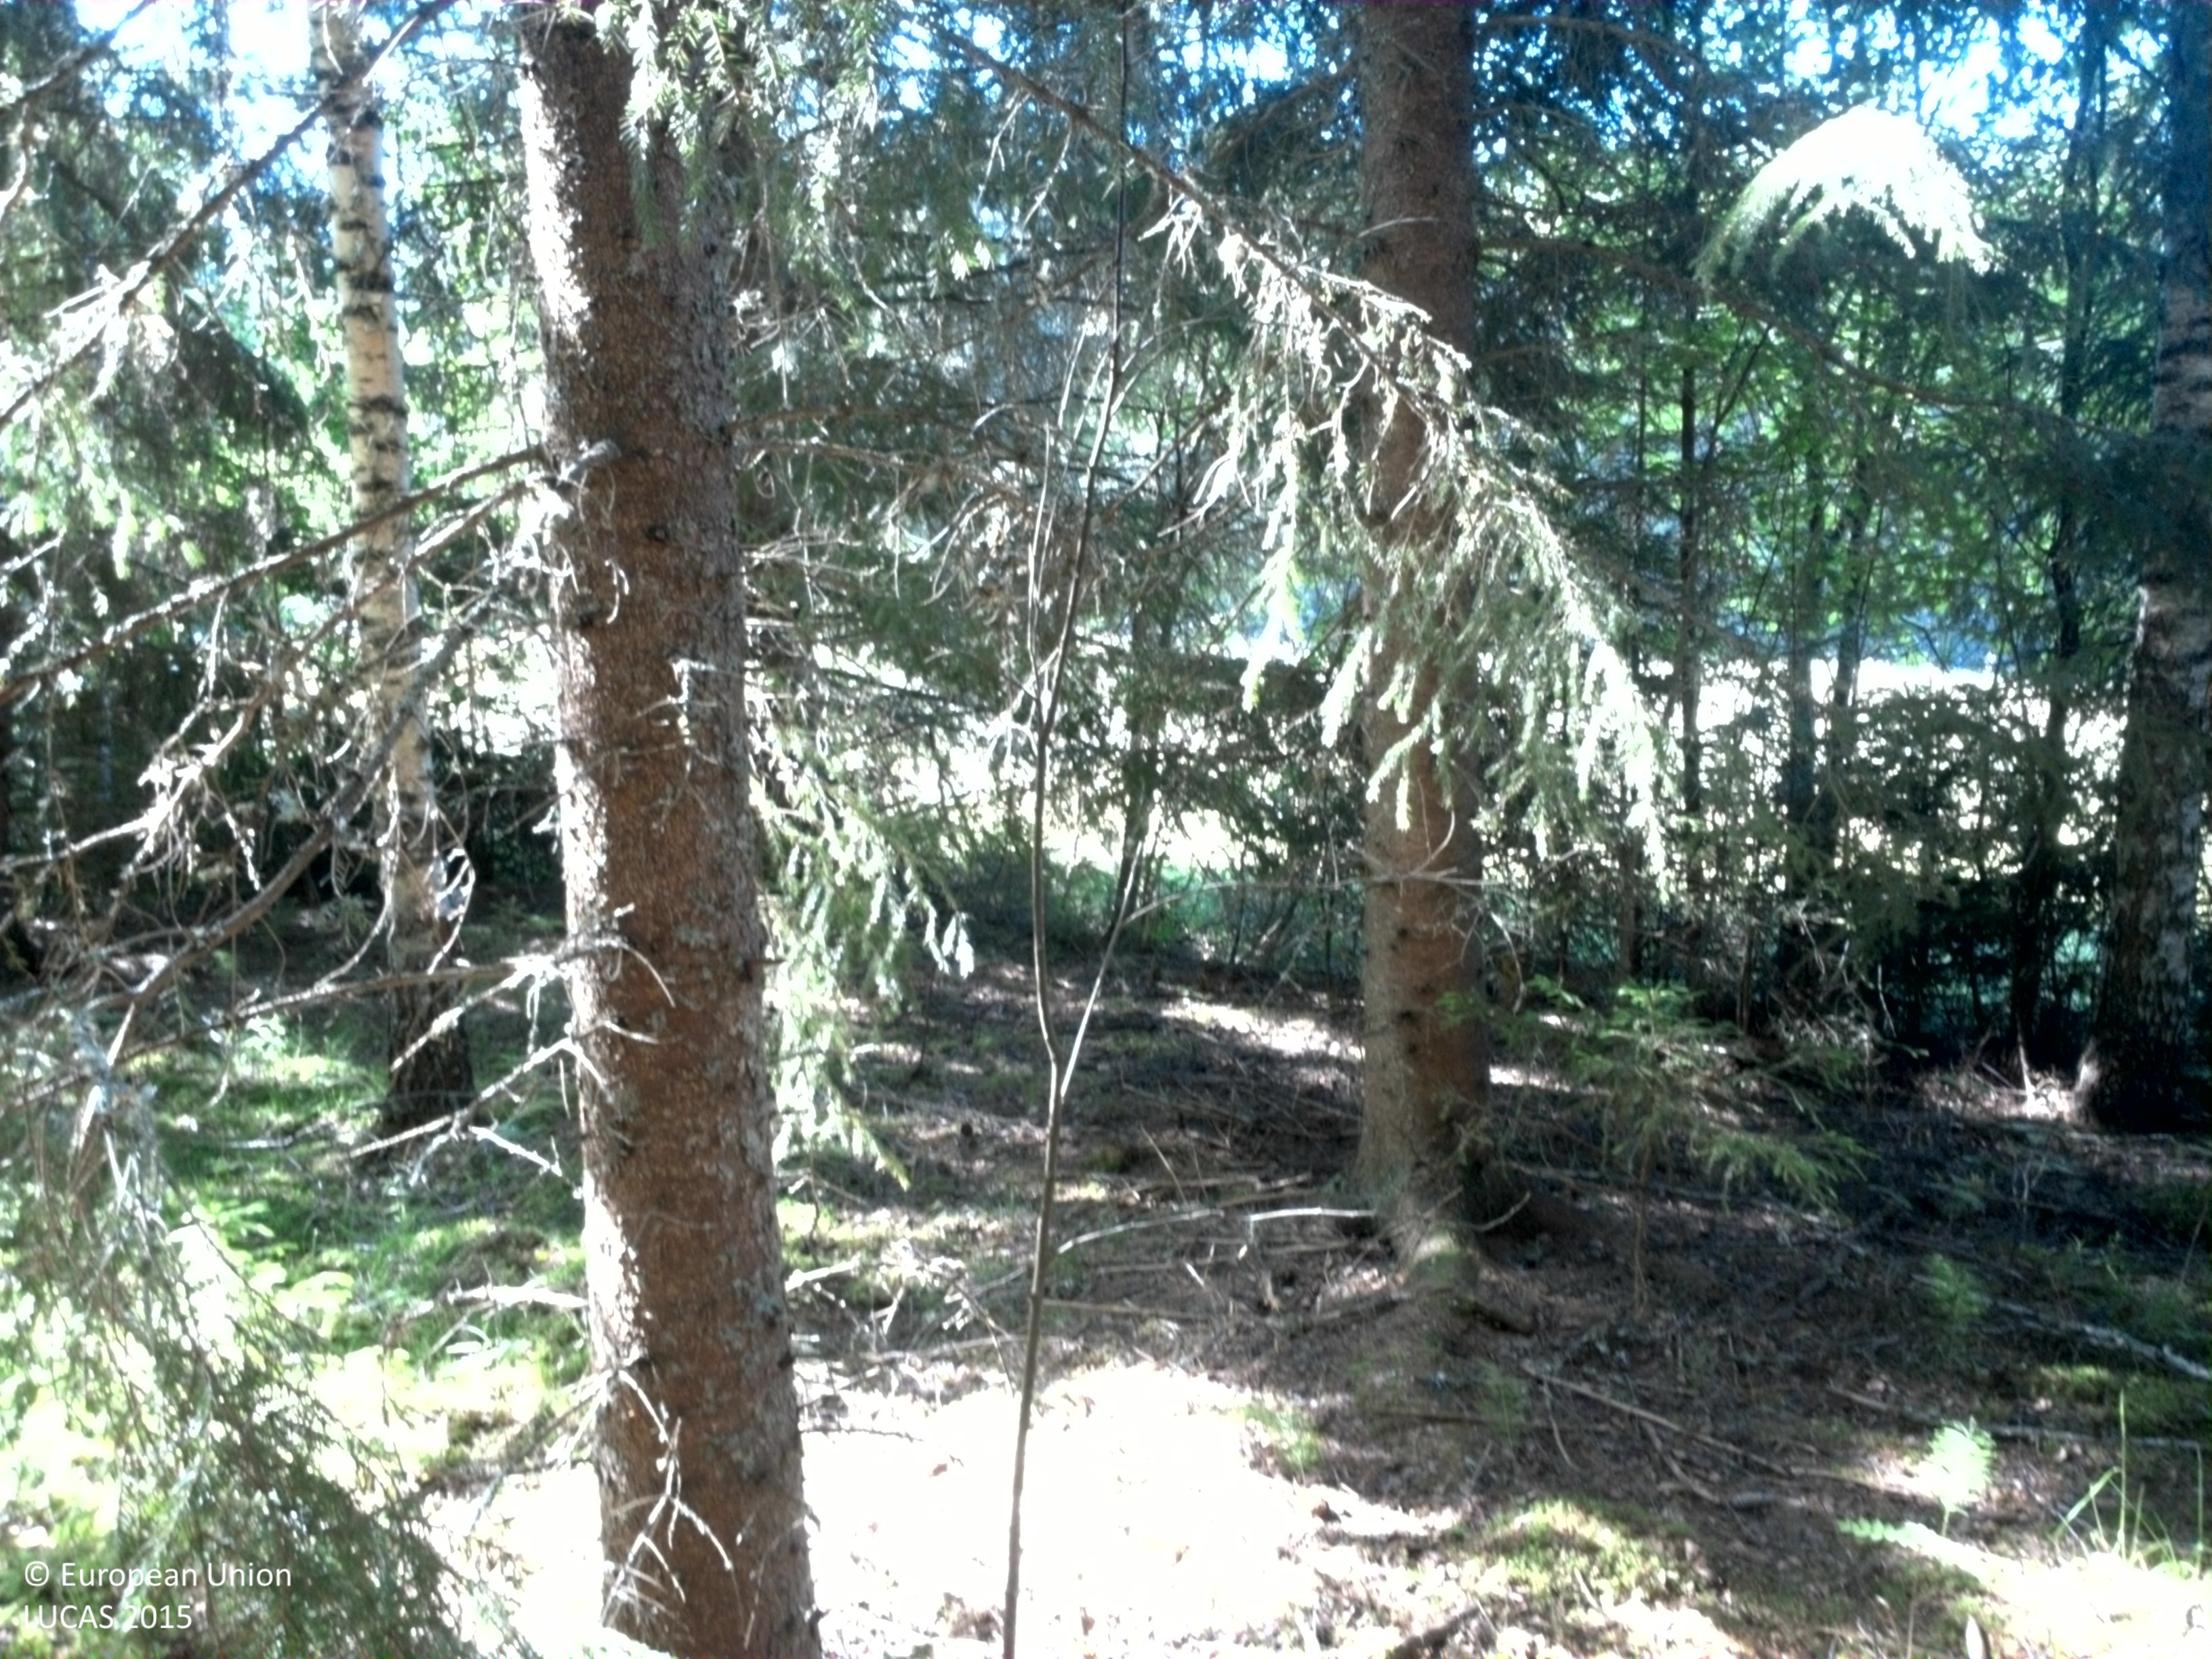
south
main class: Woodland
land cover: Spruce dominated mixed woodland
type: boreal forest
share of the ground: 50 - 75 %
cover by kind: coniferous forest trees 45 %, herbaceous plants 20 %, broadleaved forest trees 15 %, shrubs 10 %, lichens and mosses 10 %
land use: Forestry
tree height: > 5 m
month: July
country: SE
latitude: 59.9271
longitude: 12.3371
